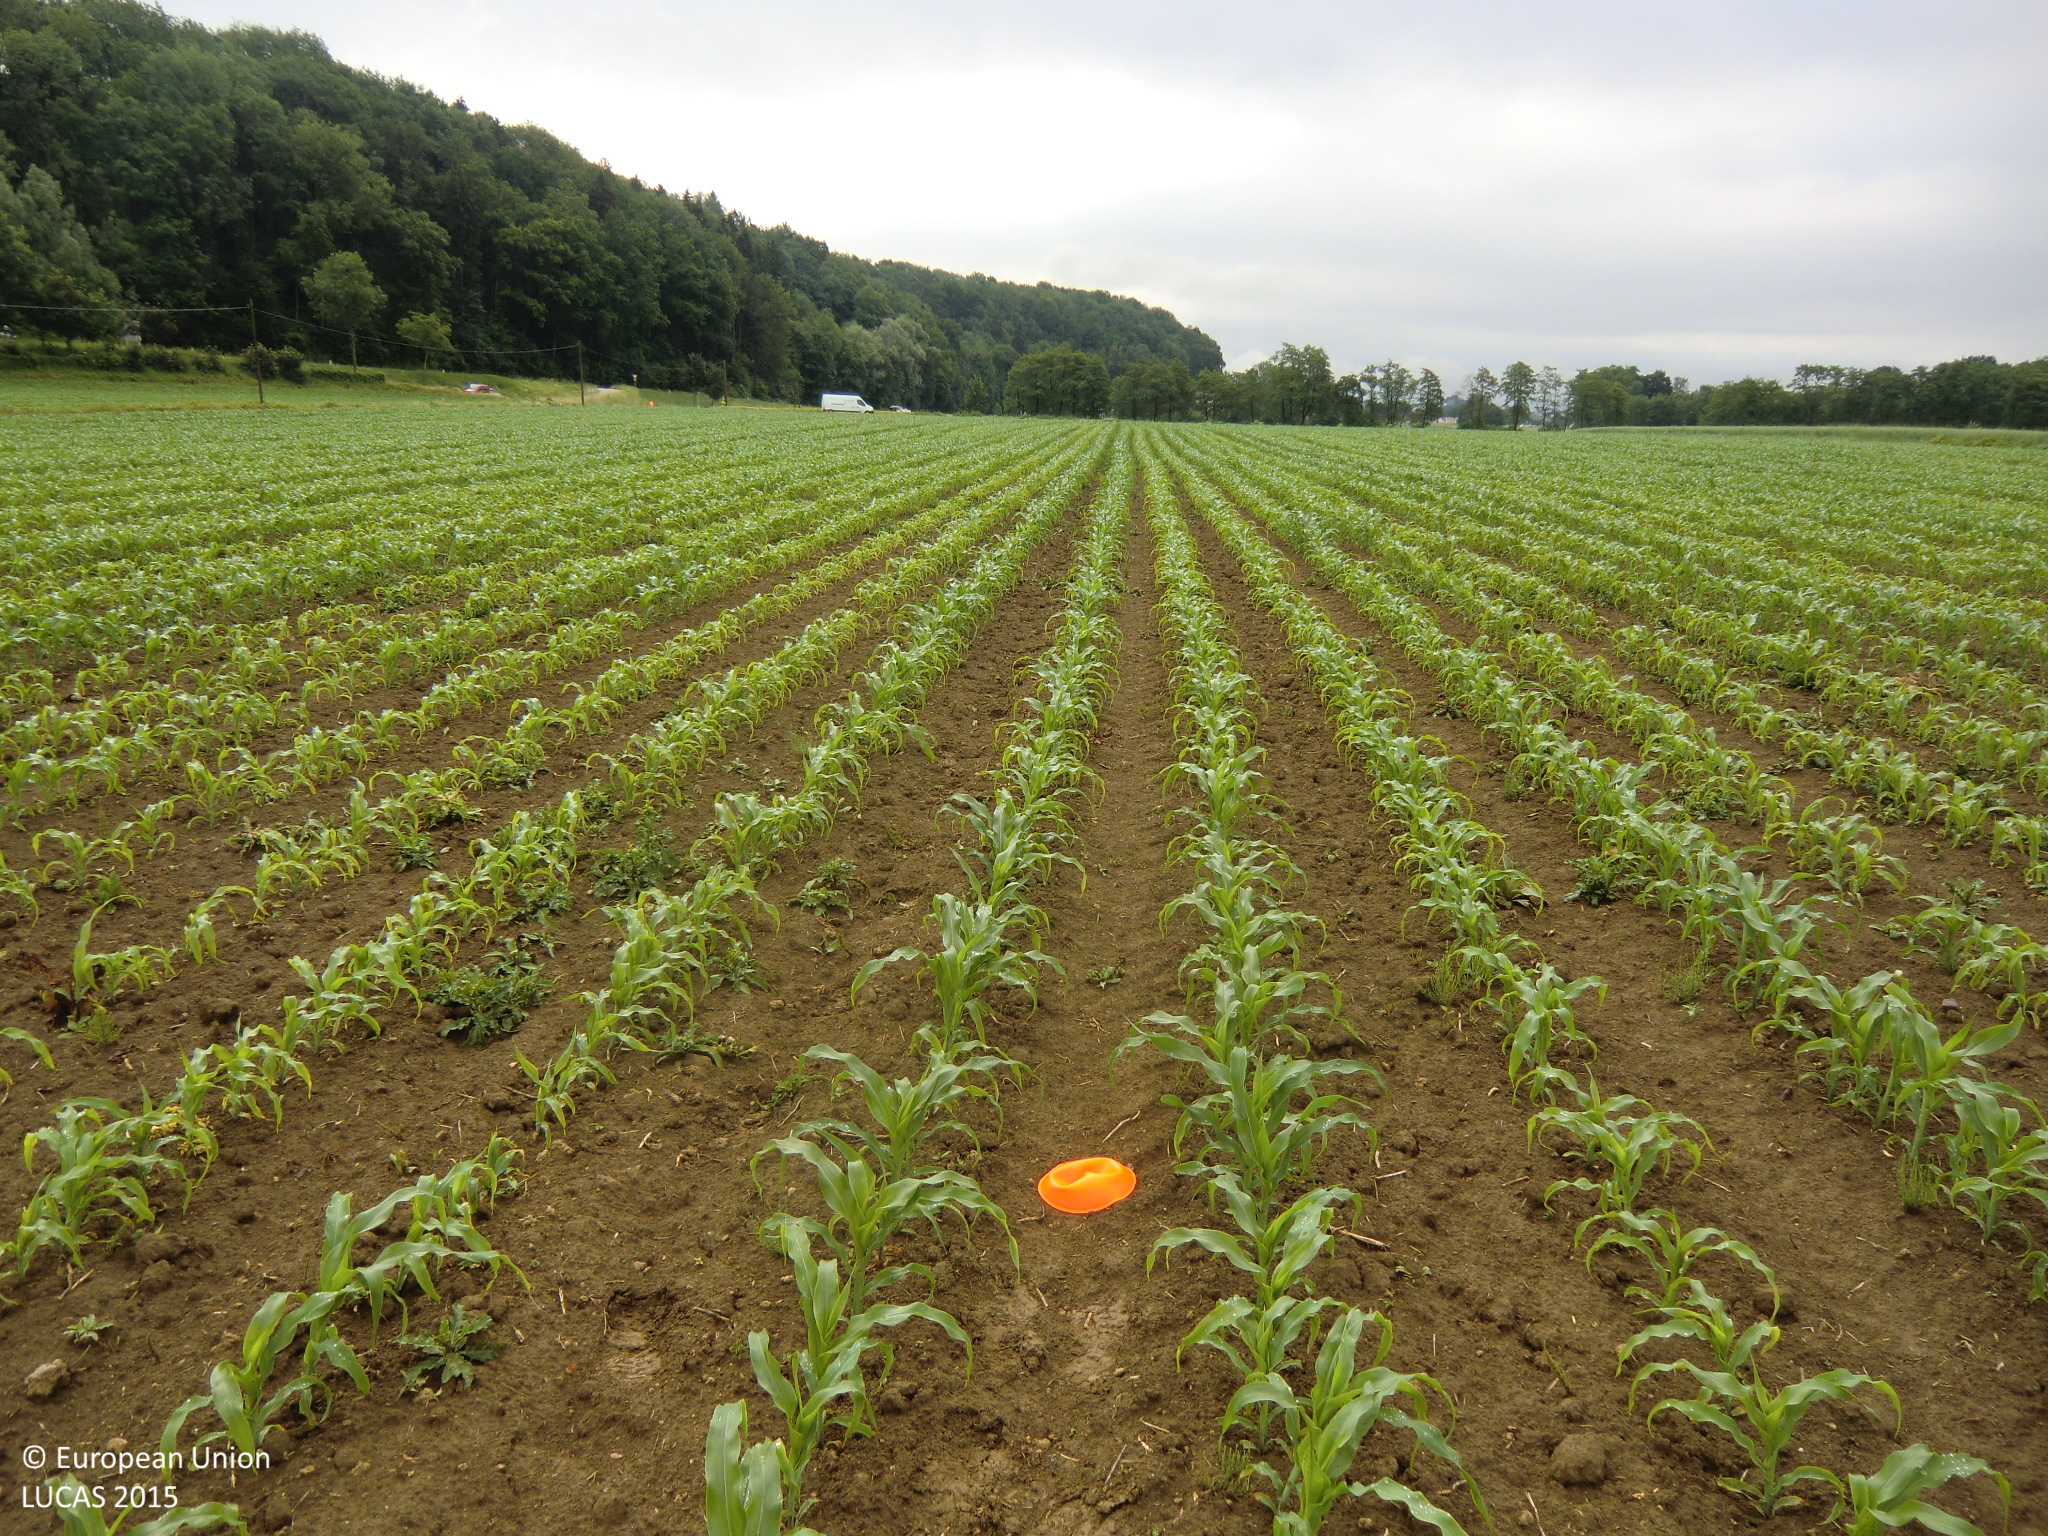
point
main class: Cropland
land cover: Maize
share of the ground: 25 - 50 %
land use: Agriculture (excluding fallow land and kitchen gardens)
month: June
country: AT
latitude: 48.2327
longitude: 14.6723
